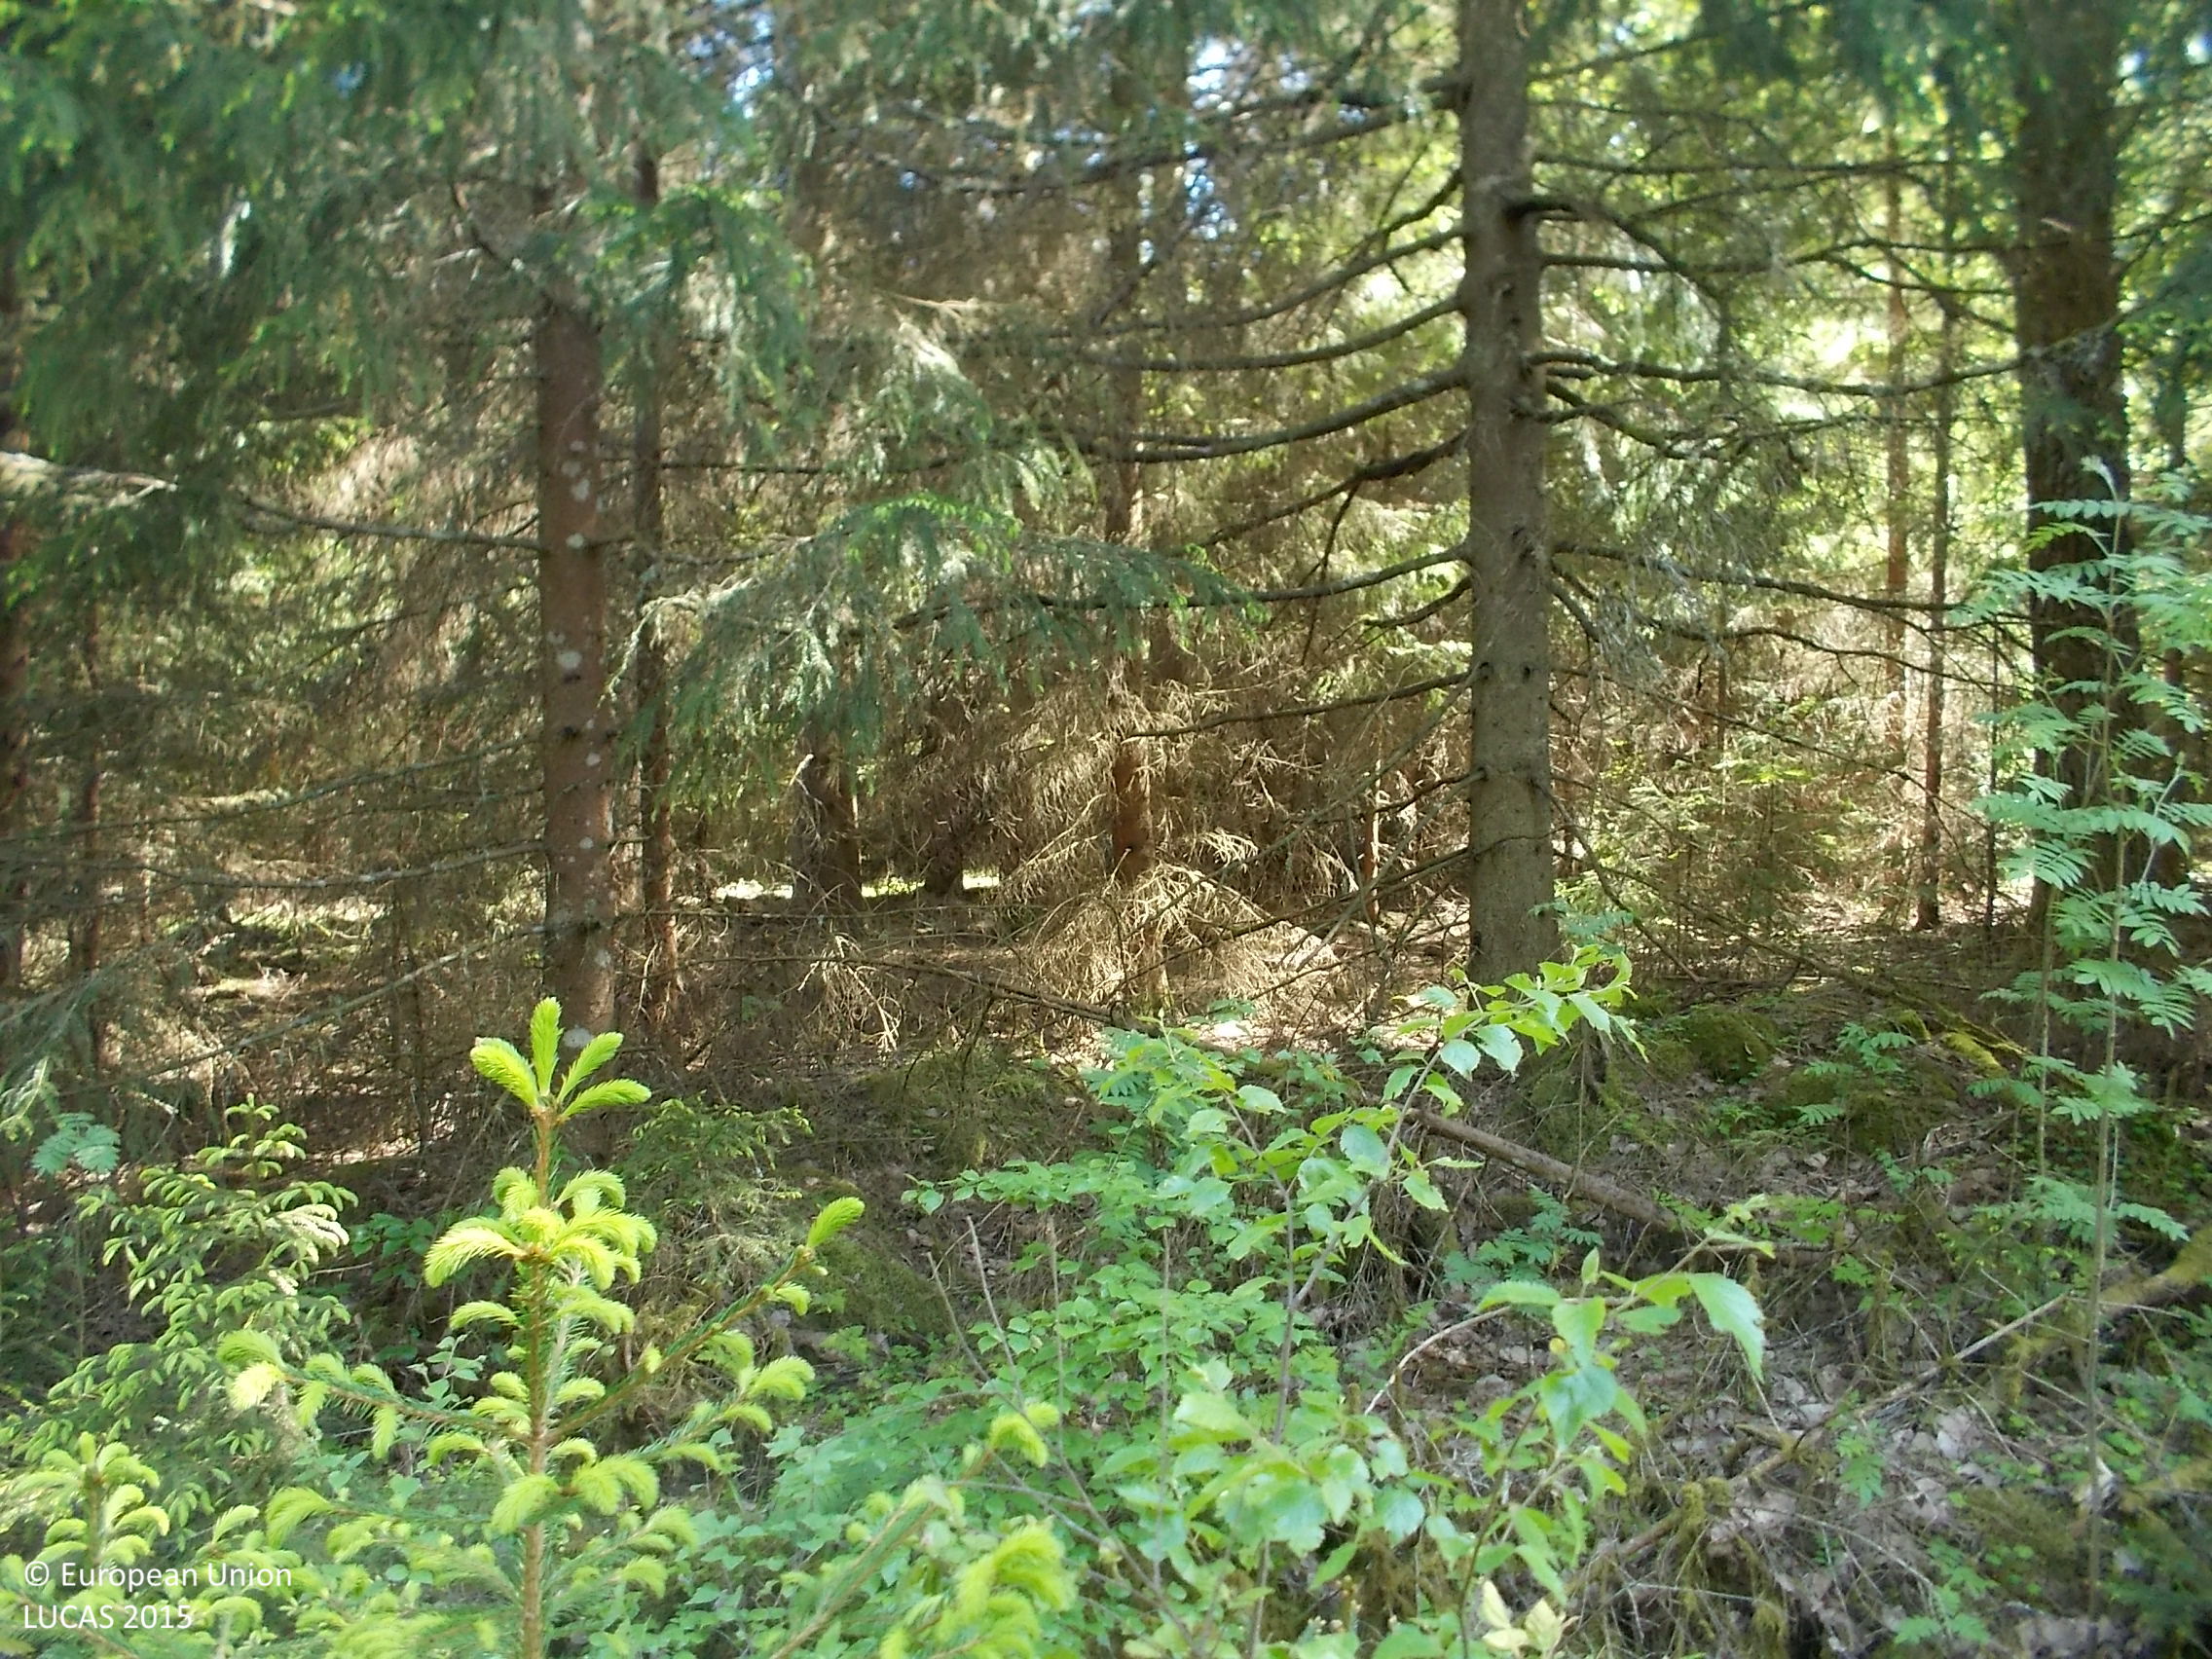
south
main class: Woodland
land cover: Spruce dominated mixed woodland
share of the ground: 25 - 50 %
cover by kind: shrubs 40 %, coniferous forest trees 25 %, broadleaved forest trees 25 %, herbaceous plants 10 %
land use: Forestry
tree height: < 5 m
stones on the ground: < 10 %
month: June
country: SE
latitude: 57.8056
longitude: 13.1085
